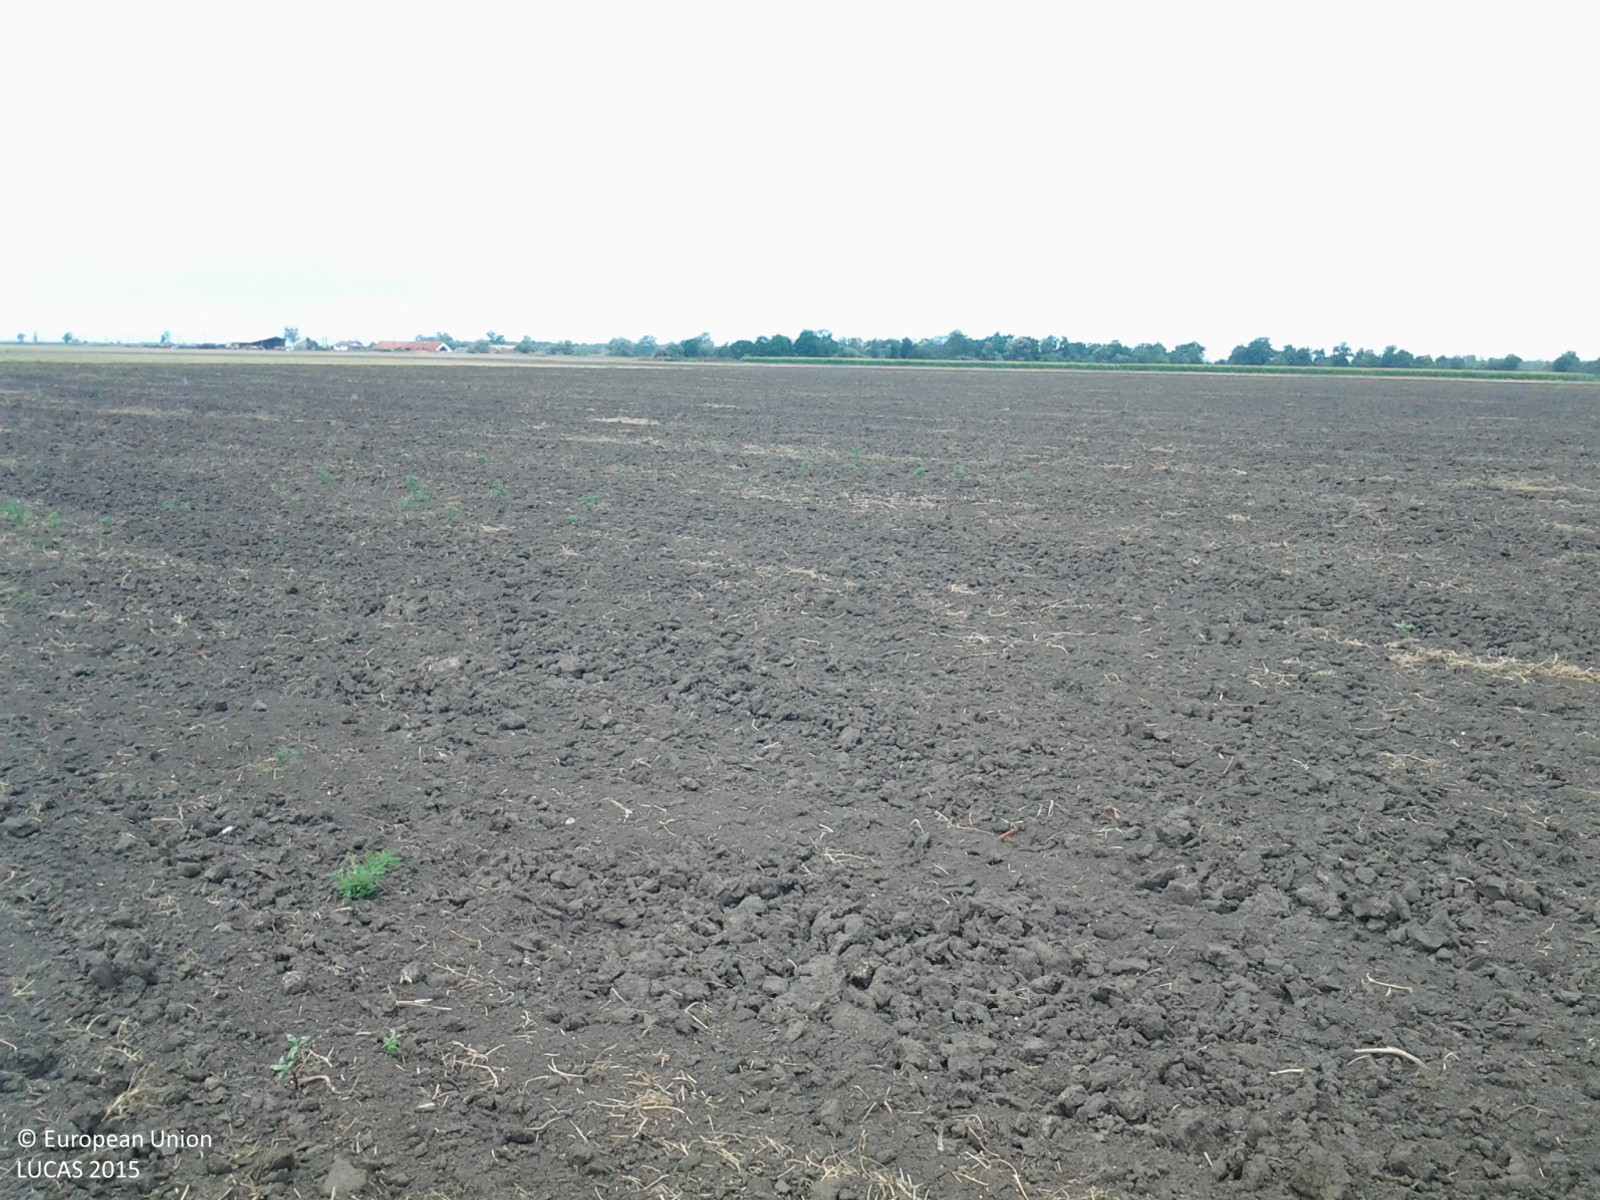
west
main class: Cropland
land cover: Dry pulses
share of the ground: < 10 %
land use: Agriculture (excluding fallow land and kitchen gardens)
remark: Harvested field
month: July
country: HU
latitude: 47.2830
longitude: 20.8888
